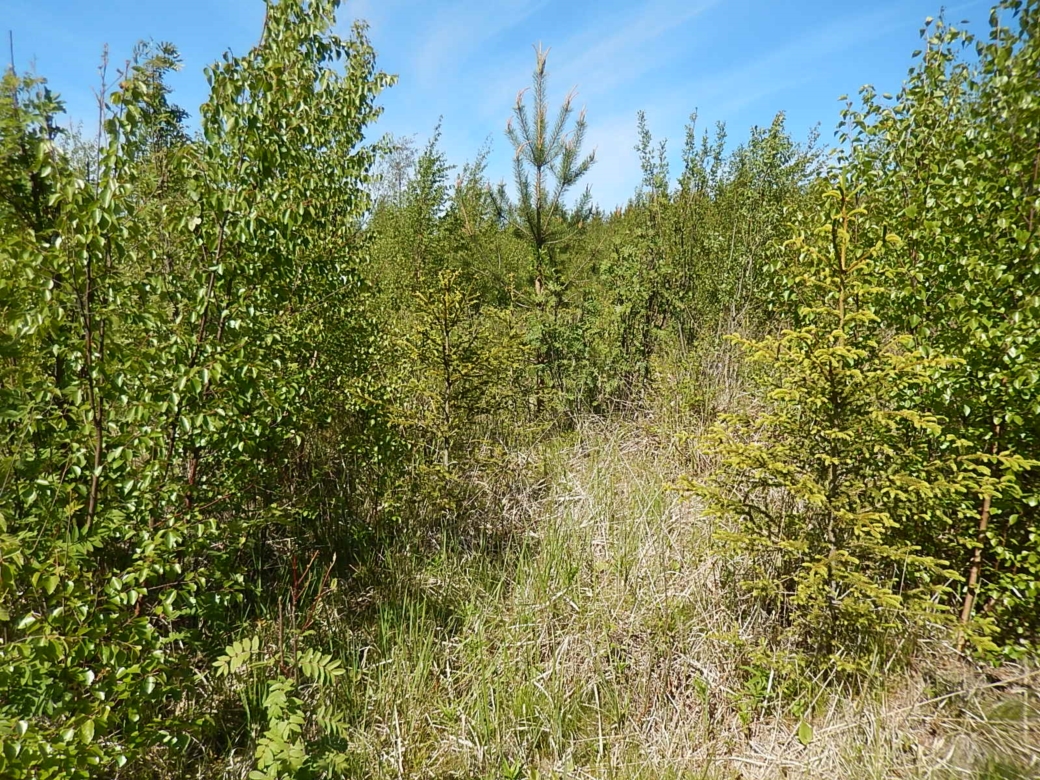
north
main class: Woodland
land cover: Other mixed woodland
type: boreal forest
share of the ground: 50 - 75 %
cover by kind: broadleaved forest trees 45 %, herbaceous plants 30 %, coniferous forest trees 25 %
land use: Forestry
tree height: < 5 m
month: June
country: FI
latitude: 62.0100
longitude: 21.4491
